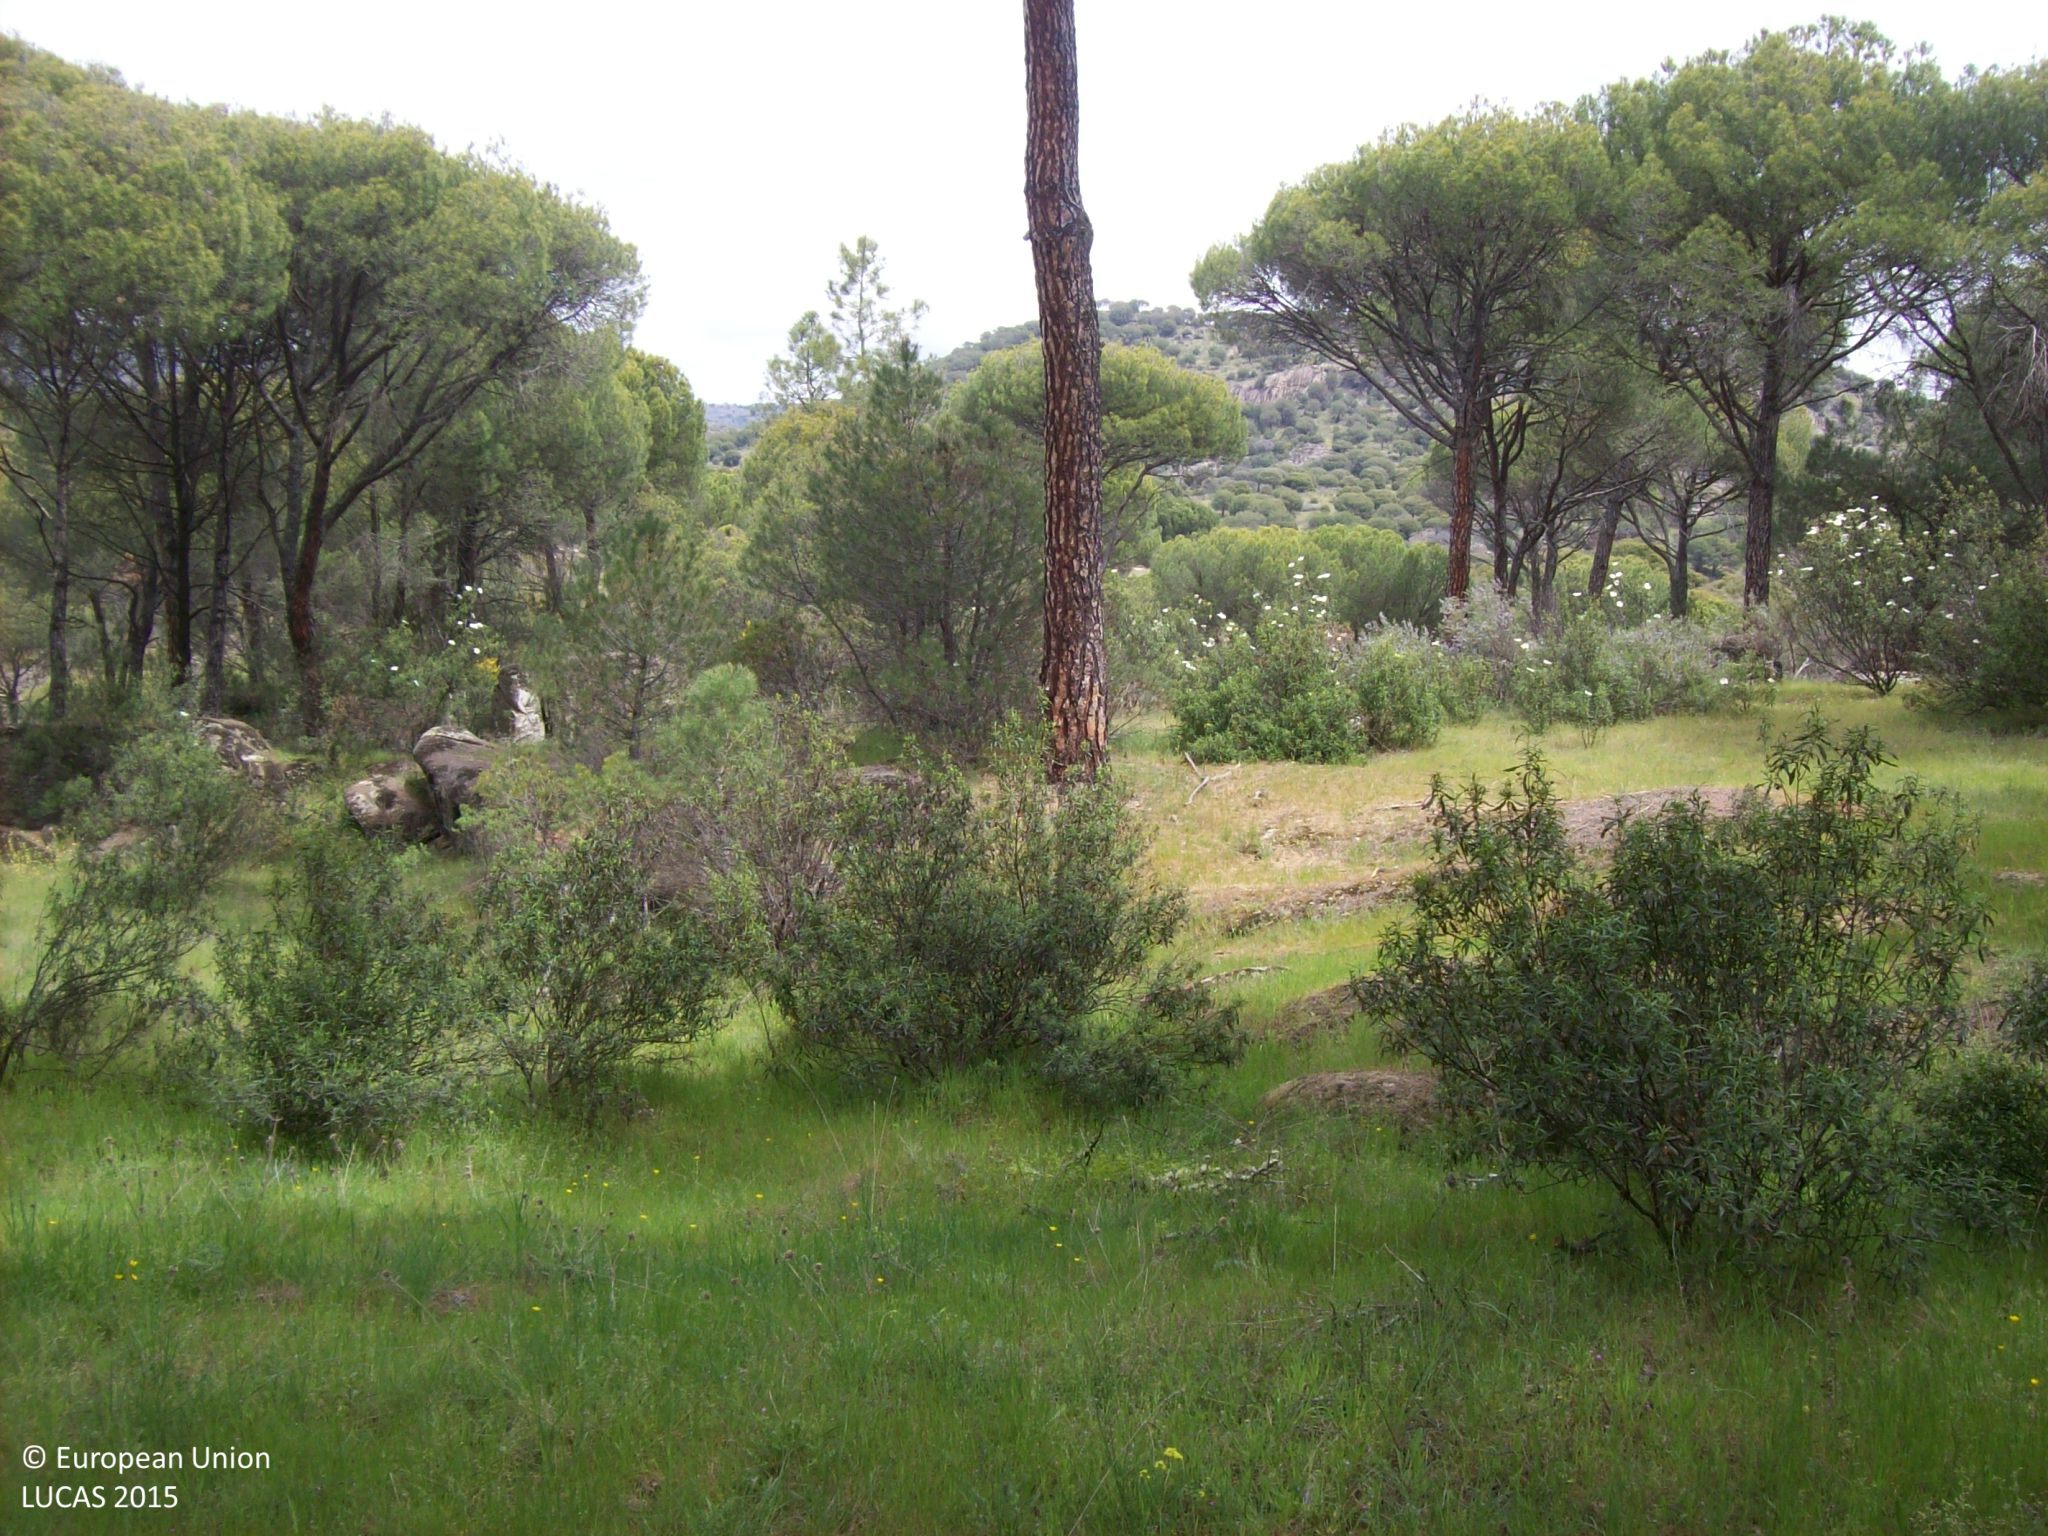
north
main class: Woodland
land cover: Pine dominated coniferous woodland
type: coniferous forest of the mediterranean region
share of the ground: > 75 %
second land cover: Grassland without tree/shrub cover
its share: > 75 %
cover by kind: coniferous forest trees 70 %, herbaceous plants 20 %, shrubs 5 %, consolidated bare surface 5 %
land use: Forestry
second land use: Agriculture (excluding fallow land and kitchen gardens)
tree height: > 5 m
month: April
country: ES
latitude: 40.4643
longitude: -4.4009
